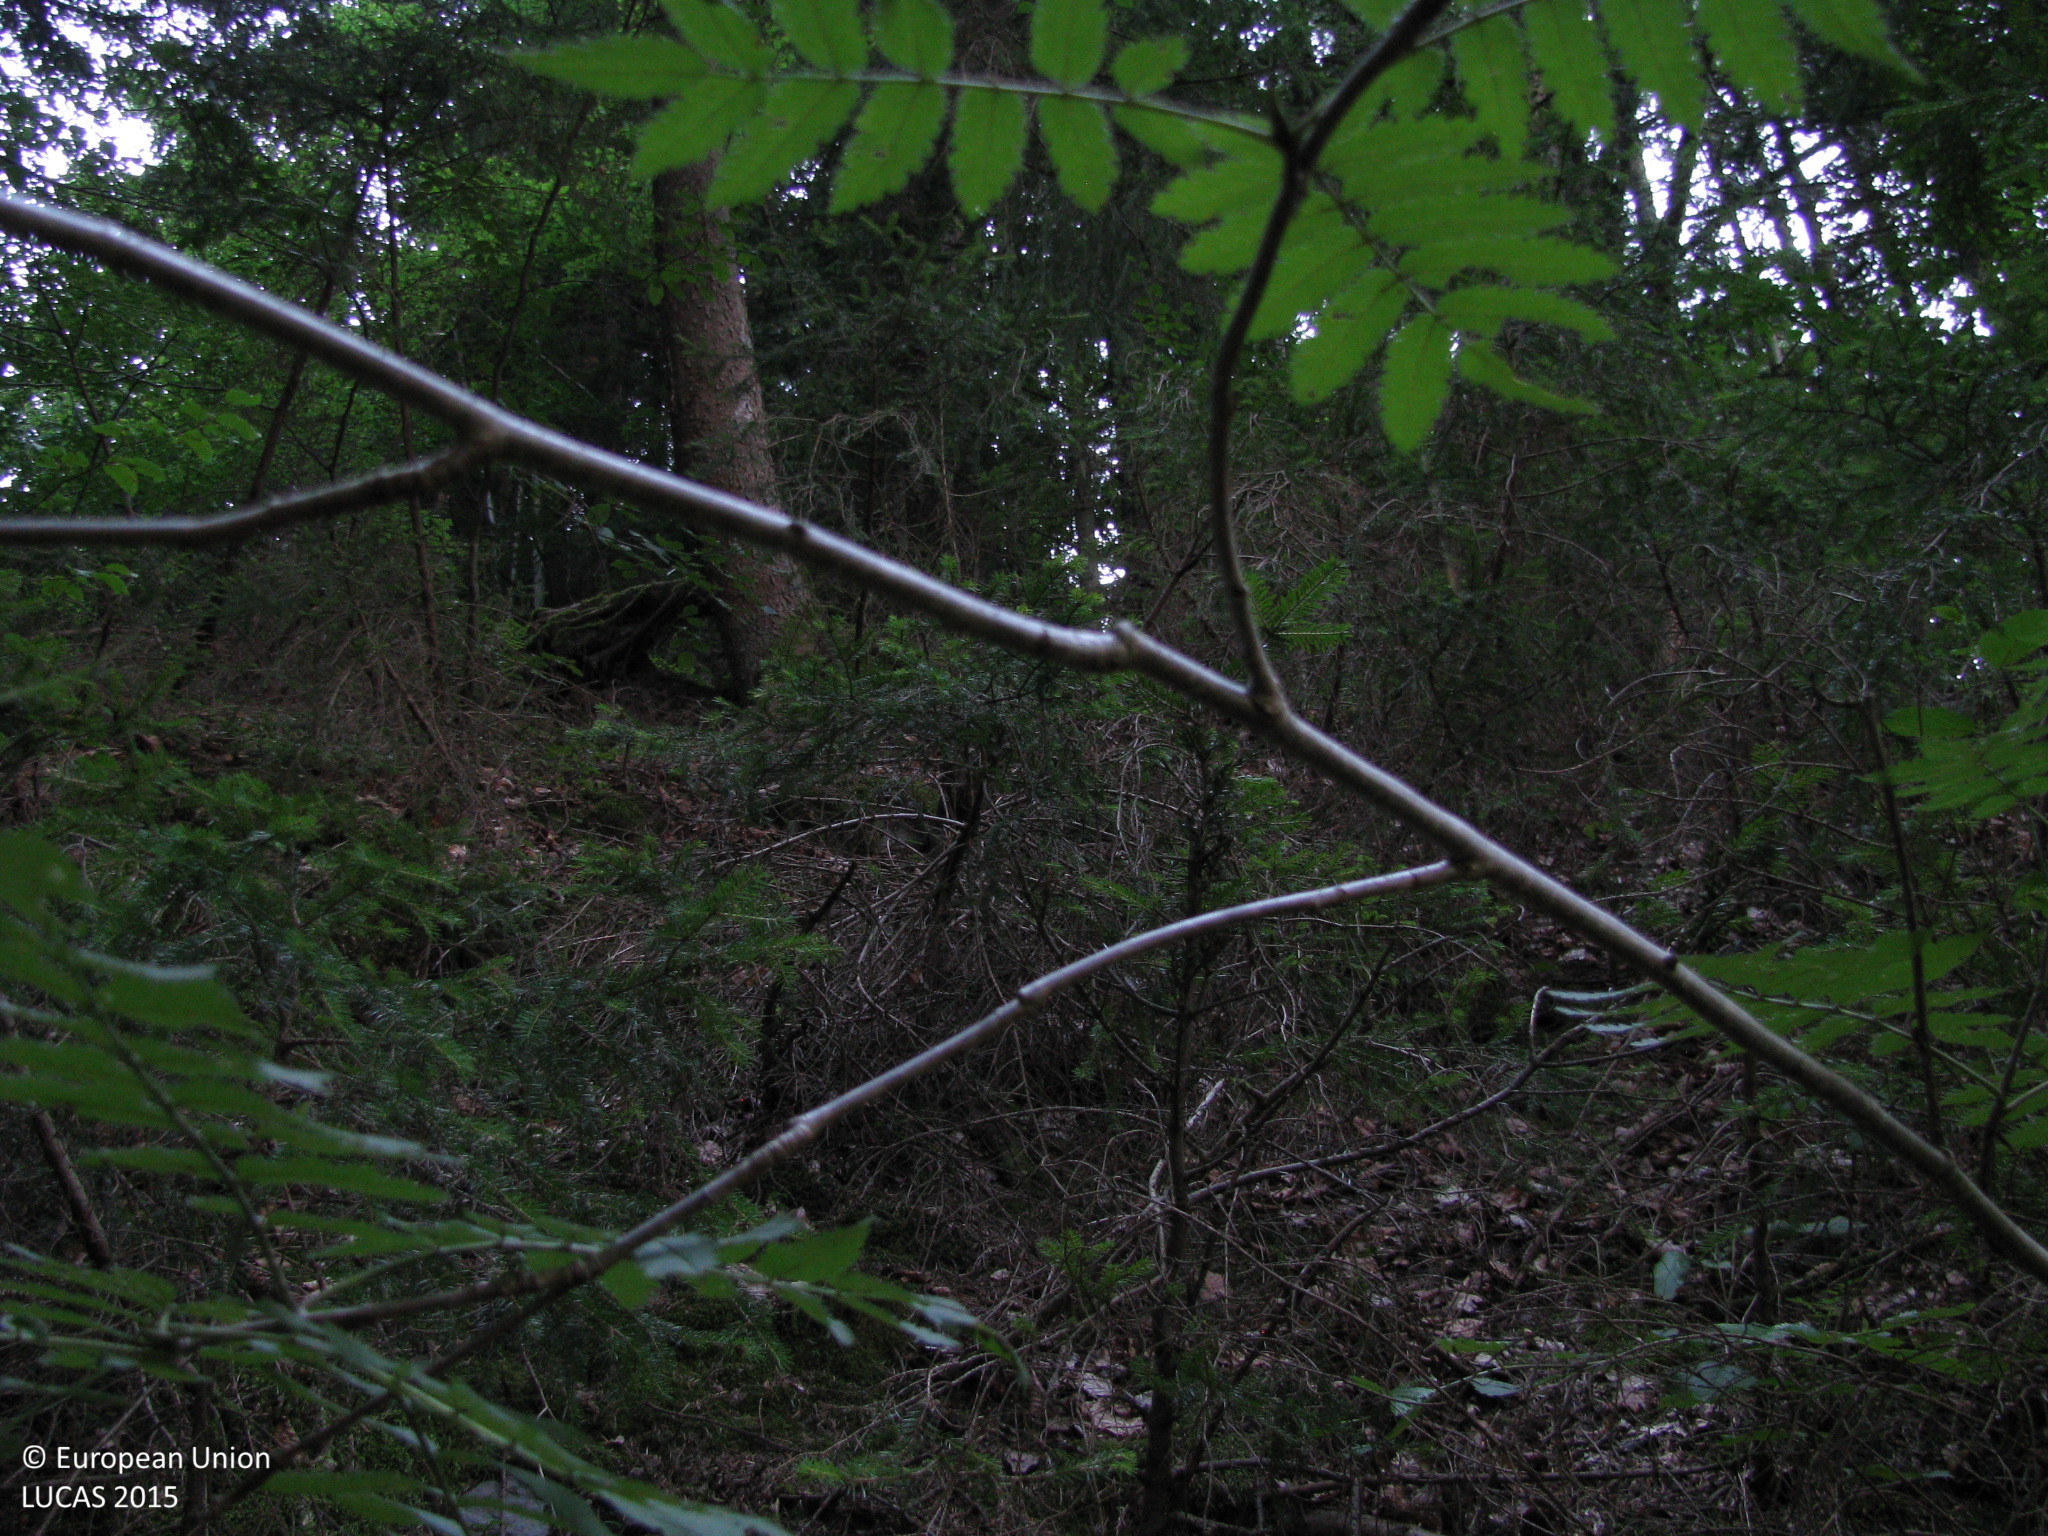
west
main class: Woodland
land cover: Other coniferous woodland
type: alpine coniferous forest
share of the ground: > 75 %
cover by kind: coniferous forest trees 75 %, broadleaved forest trees 15 %, herbaceous plants 10 %
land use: Forestry
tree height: > 5 m
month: July
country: AT
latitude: 46.6741
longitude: 12.8340
